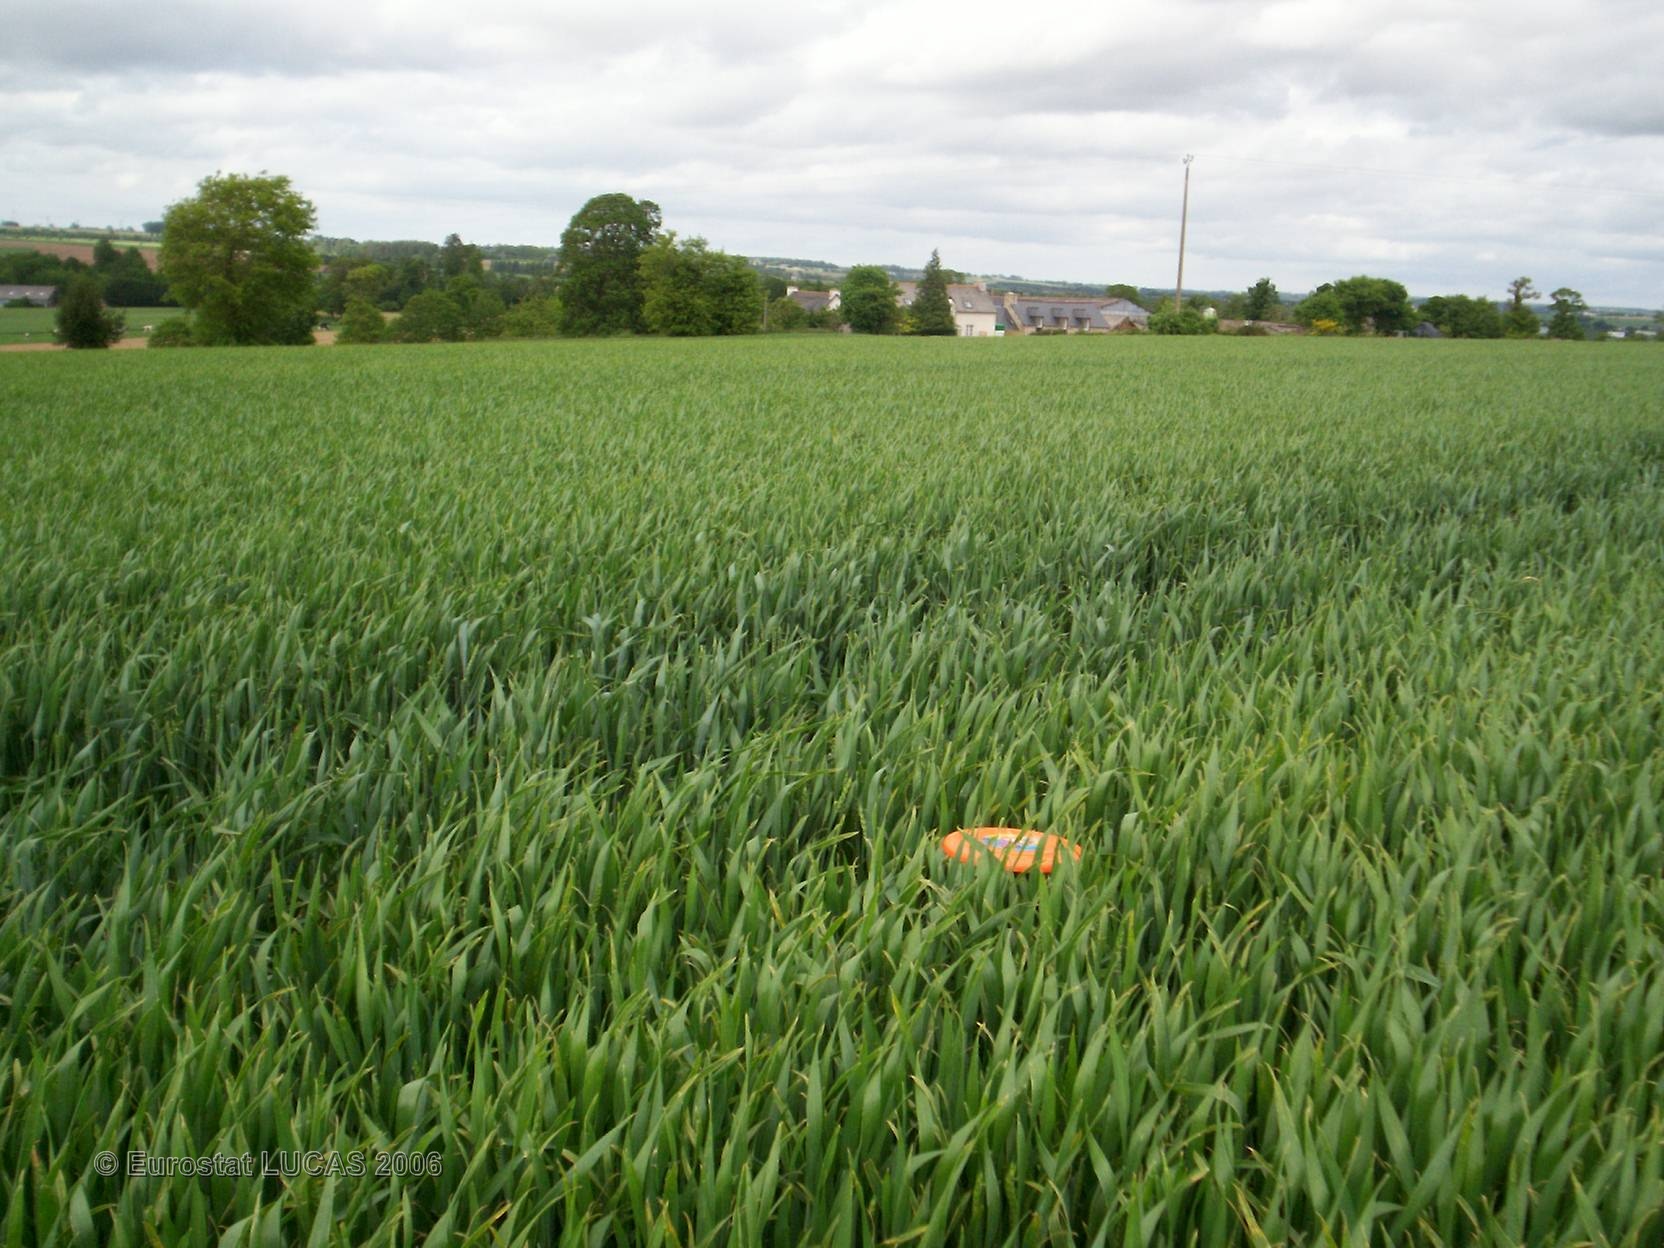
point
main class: Cropland
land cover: Common wheat
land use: Agriculture (excluding fallow land and kitchen gardens)
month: May
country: FR
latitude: 48.3597
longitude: -2.3816
